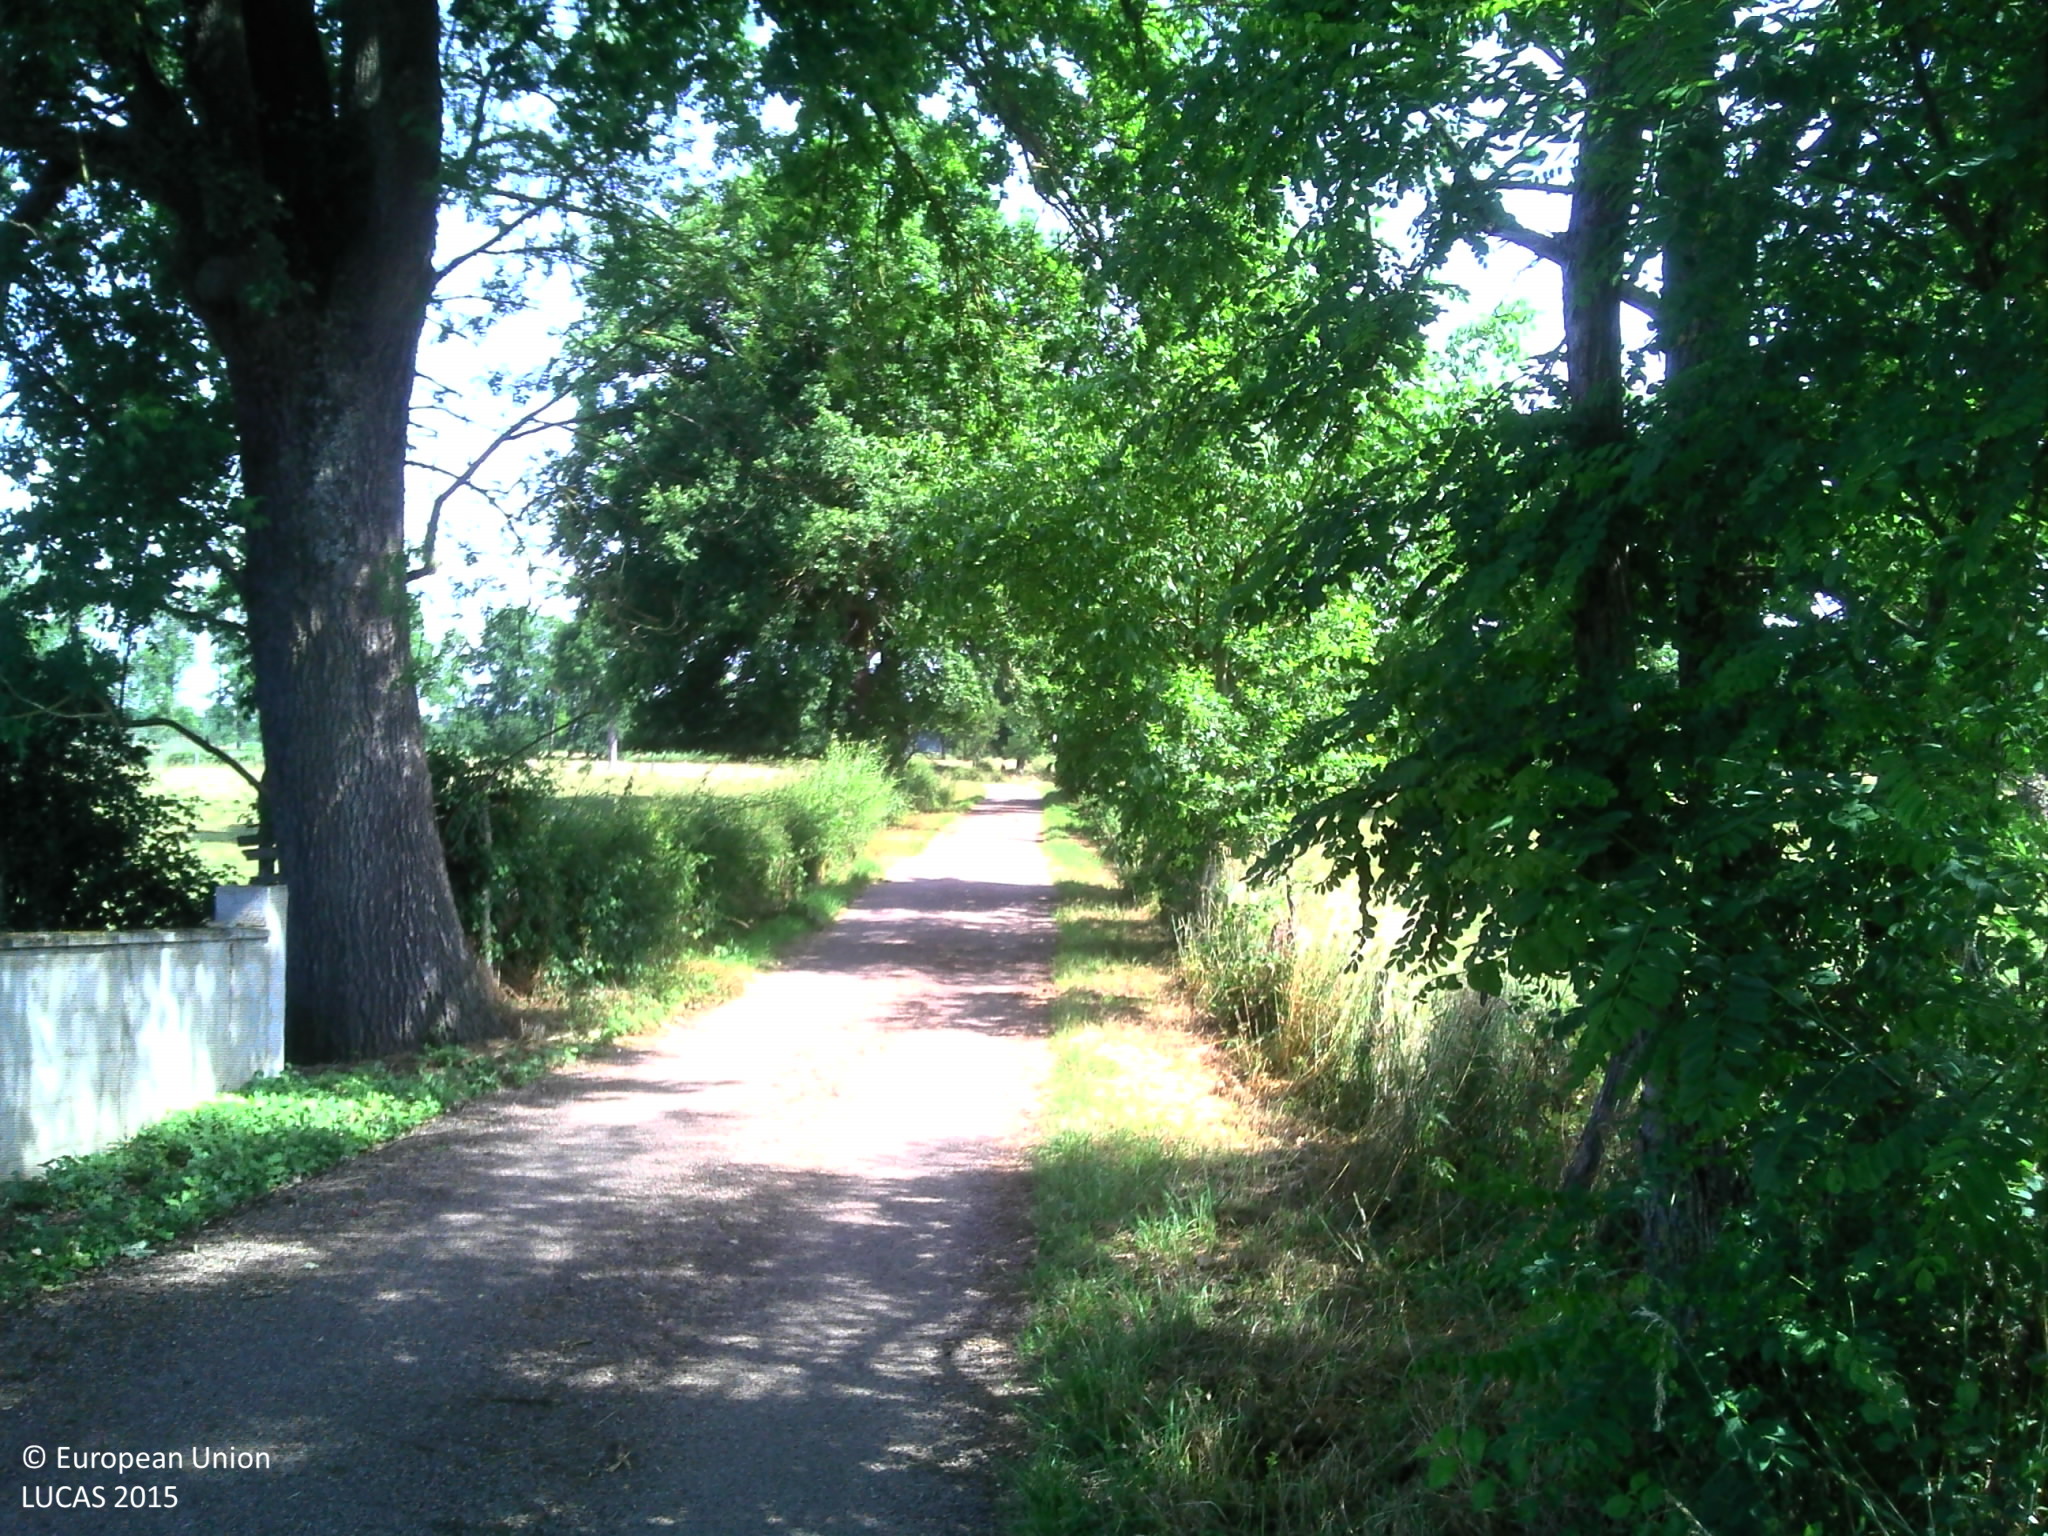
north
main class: Grassland
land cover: Grassland without tree/shrub cover
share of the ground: > 75 %
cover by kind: herbaceous plants 100 %
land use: Agriculture (excluding fallow land and kitchen gardens)
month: June
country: FR
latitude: 46.3638
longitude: 4.0086
